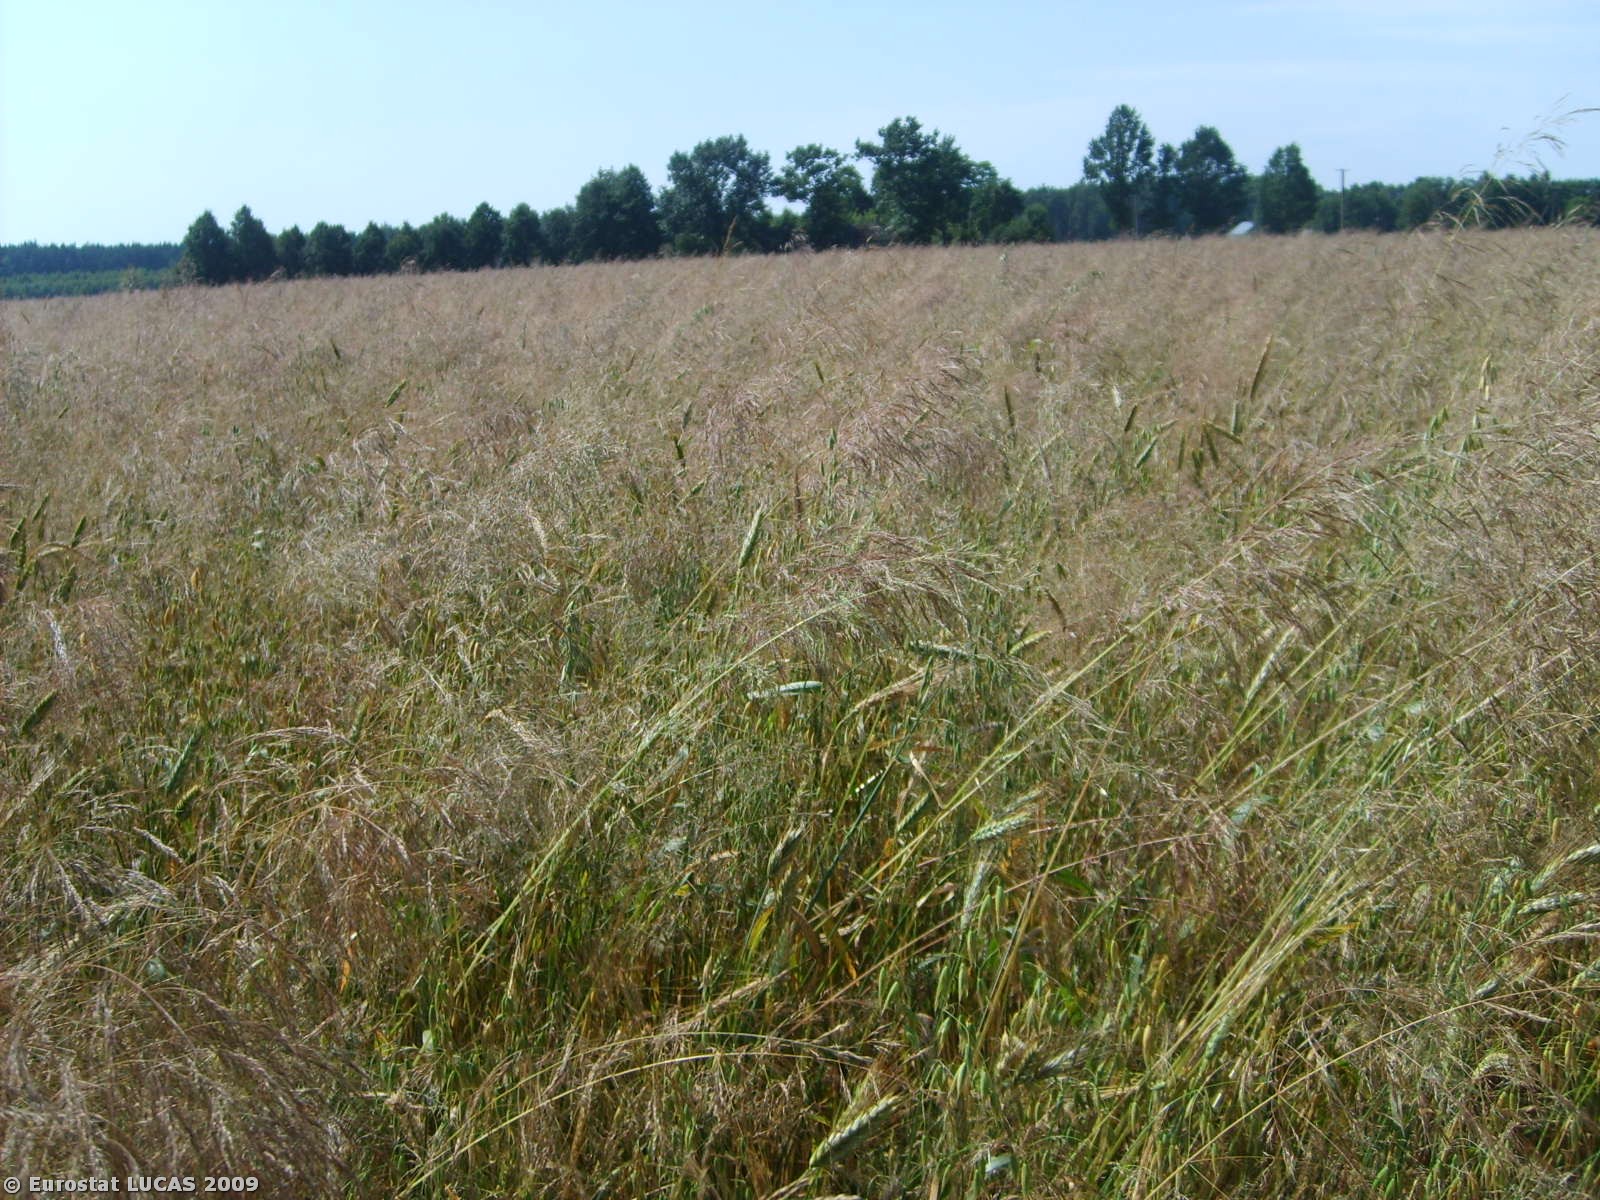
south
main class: Cropland
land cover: Mixed cereals for fodder
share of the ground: > 75 %
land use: Agriculture (excluding fallow land and kitchen gardens)
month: July
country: PL
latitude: 52.4424
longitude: 21.6009
